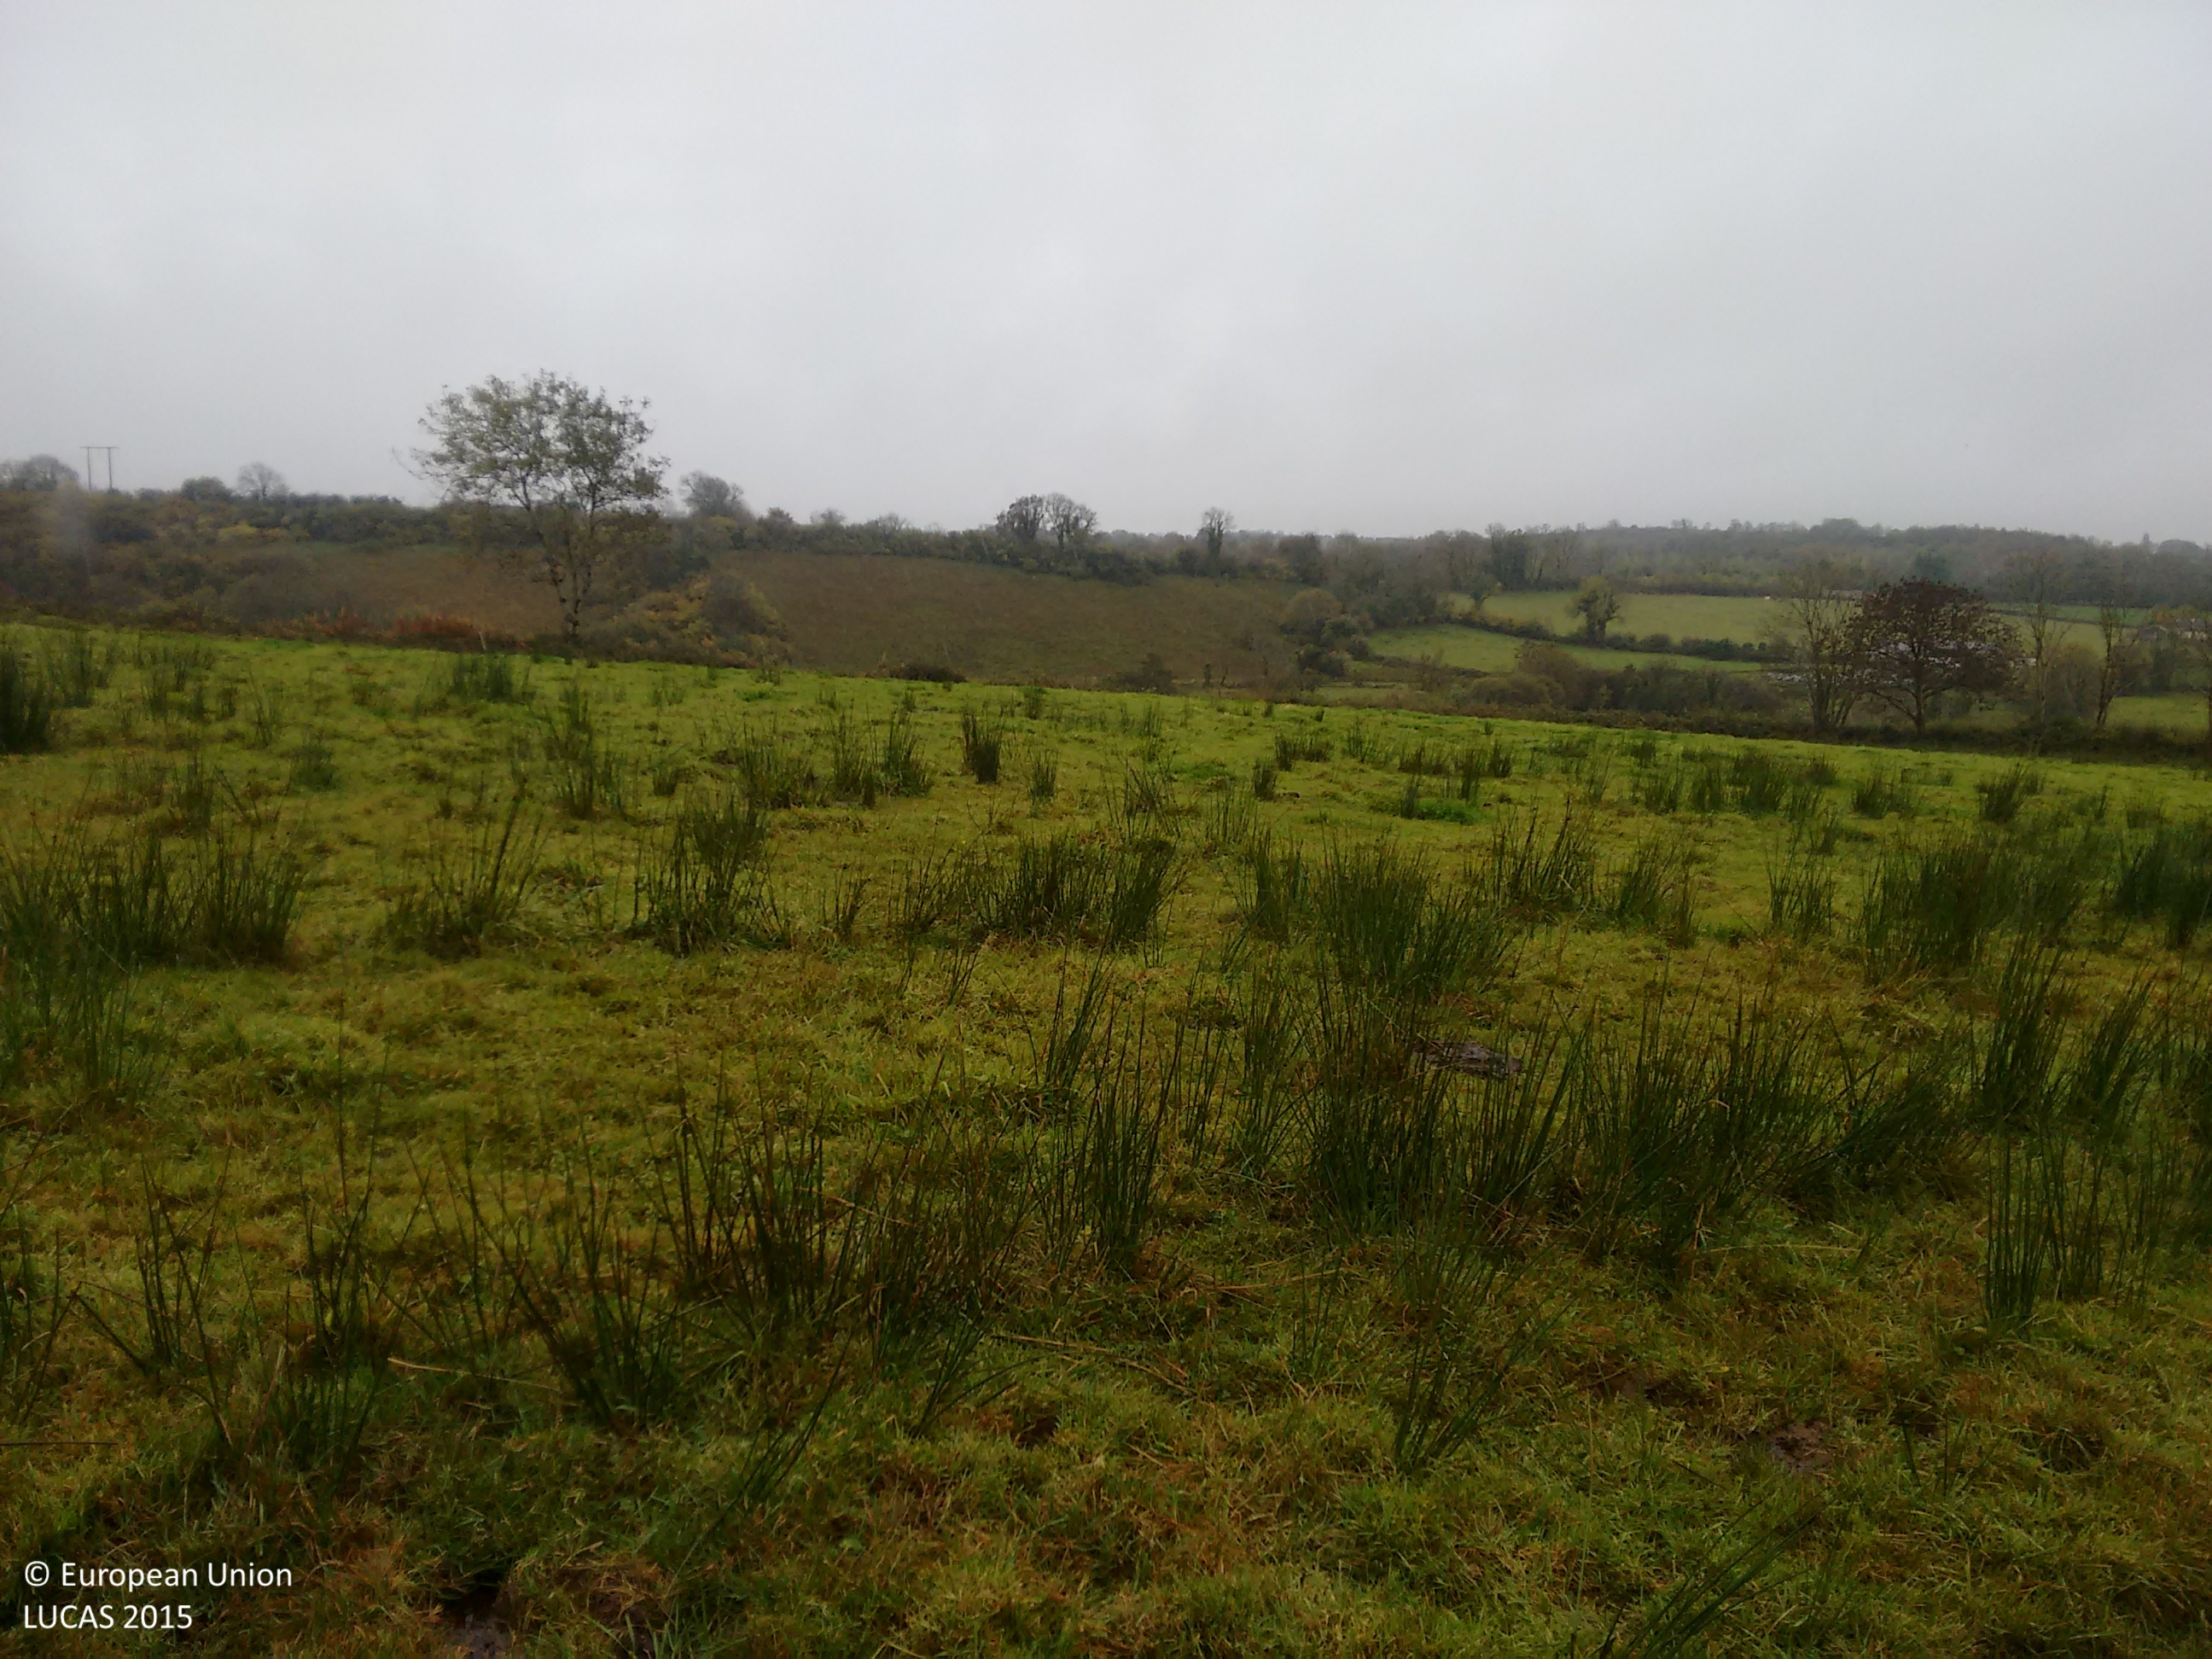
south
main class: Grassland
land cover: Grassland without tree/shrub cover
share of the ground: > 75 %
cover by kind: herbaceous plants 100 %
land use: Agriculture (excluding fallow land and kitchen gardens)
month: October
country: IE
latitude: 53.9353
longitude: -8.1378
